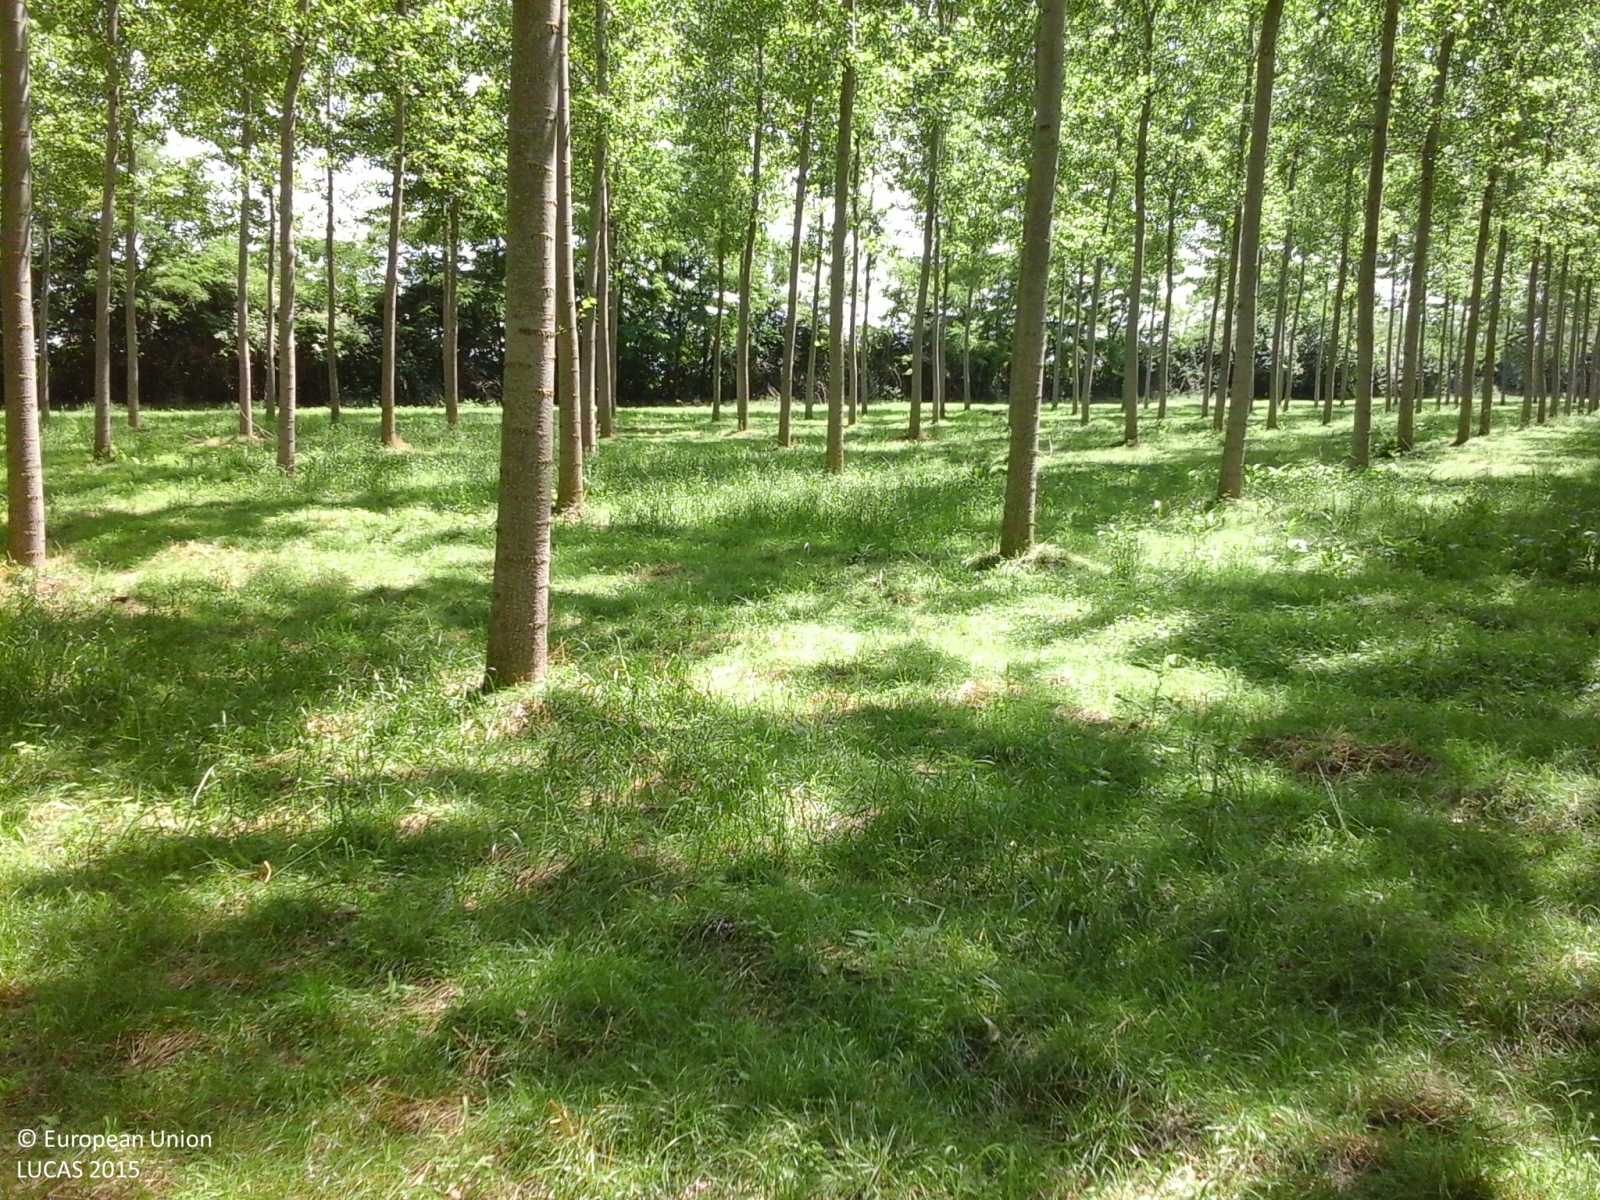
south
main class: Woodland
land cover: Broadleaved woodland
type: non-riverine alder, birch or aspen forest
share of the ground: > 75 %
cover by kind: broadleaved forest trees 100 %
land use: Forestry
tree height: > 5 m
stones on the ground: < 10 %
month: June
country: IT
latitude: 44.8857
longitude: 7.7632
